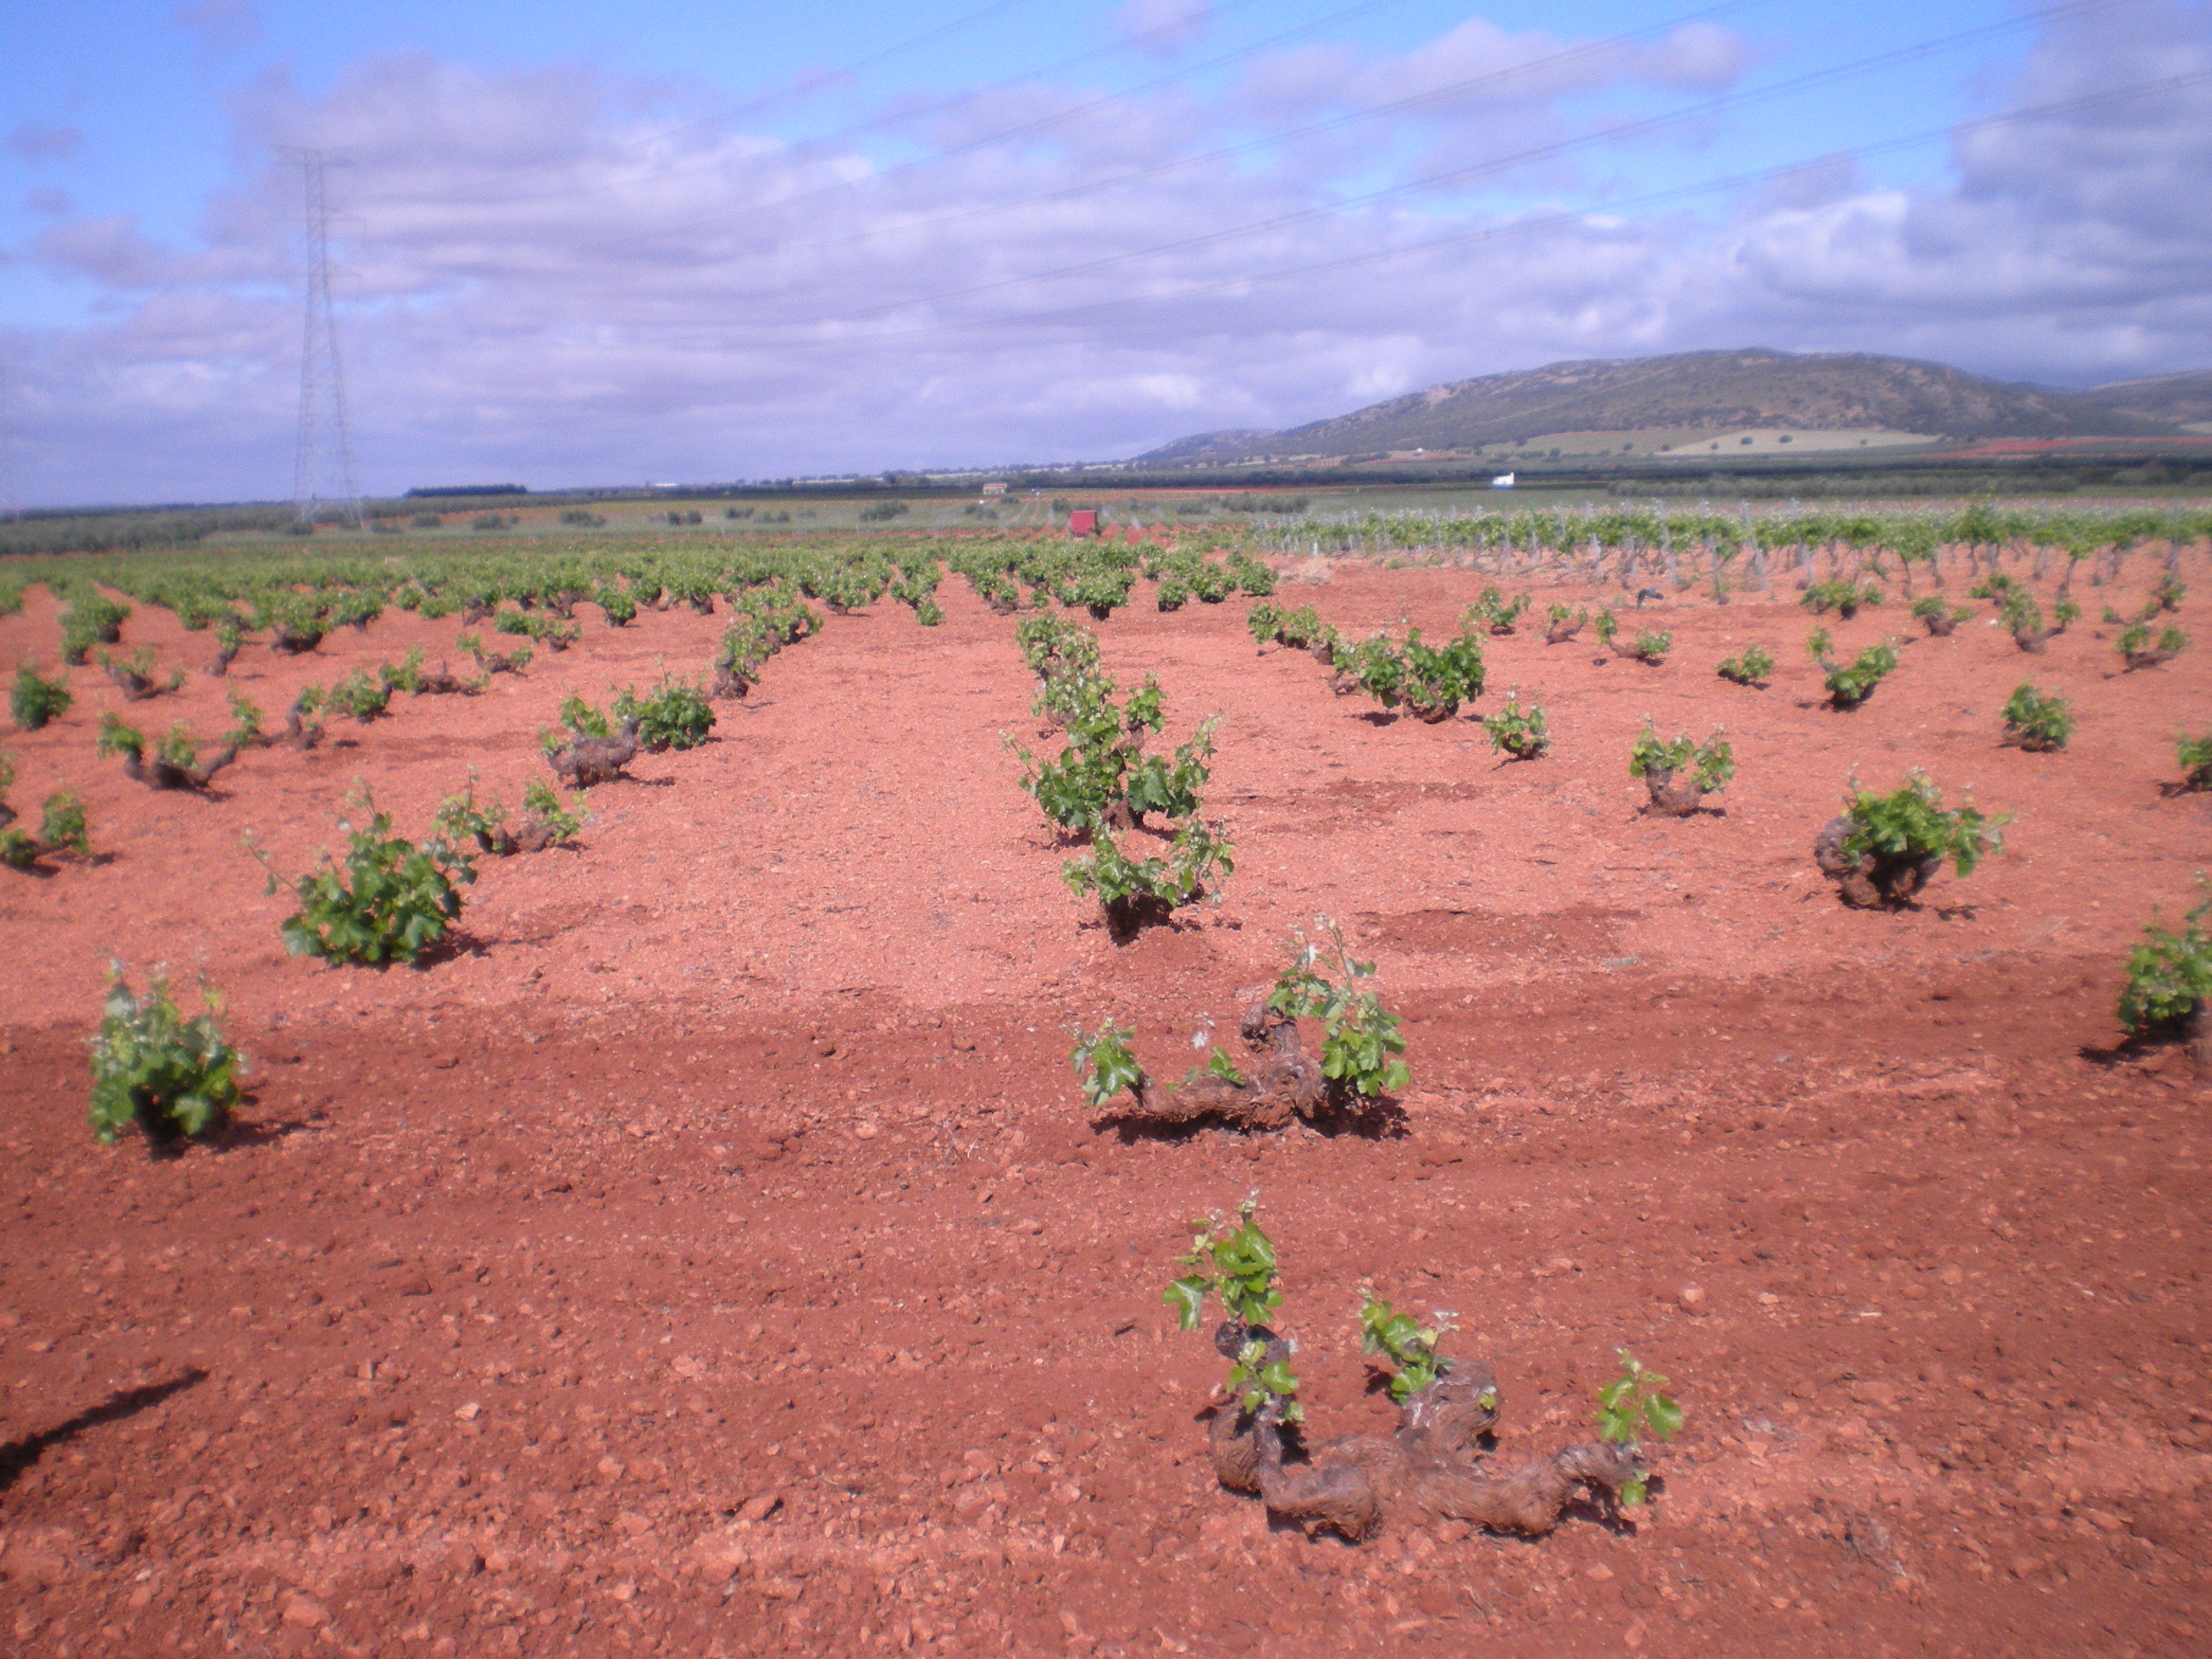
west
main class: Cropland
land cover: Vineyards
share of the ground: 10 - 25 %
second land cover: Other bare soil
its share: > 75 %
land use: Agriculture (excluding fallow land and kitchen gardens)
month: May
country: ES
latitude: 38.8083
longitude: -3.4279
